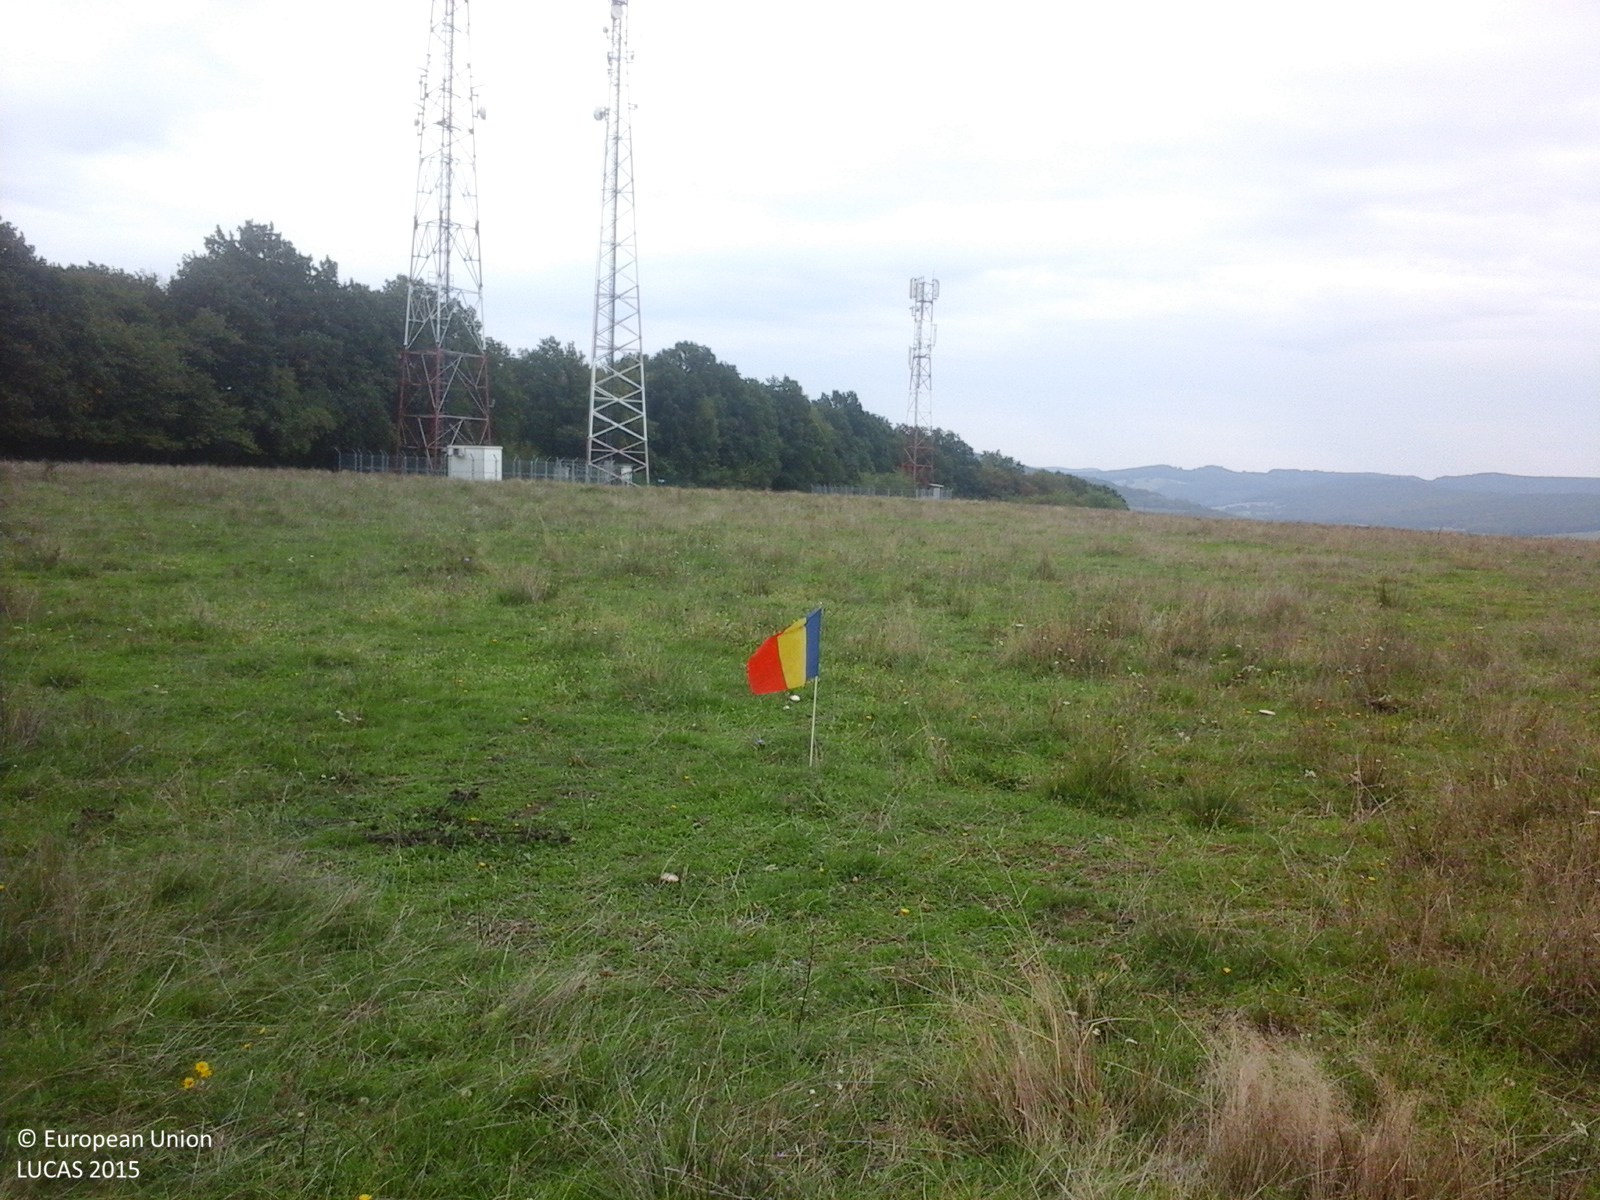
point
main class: Grassland
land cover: Grassland without tree/shrub cover
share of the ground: > 75 %
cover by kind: herbaceous plants 100 %
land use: Agriculture (excluding fallow land and kitchen gardens)
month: October
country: RO
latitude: 46.5280
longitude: 24.7589
